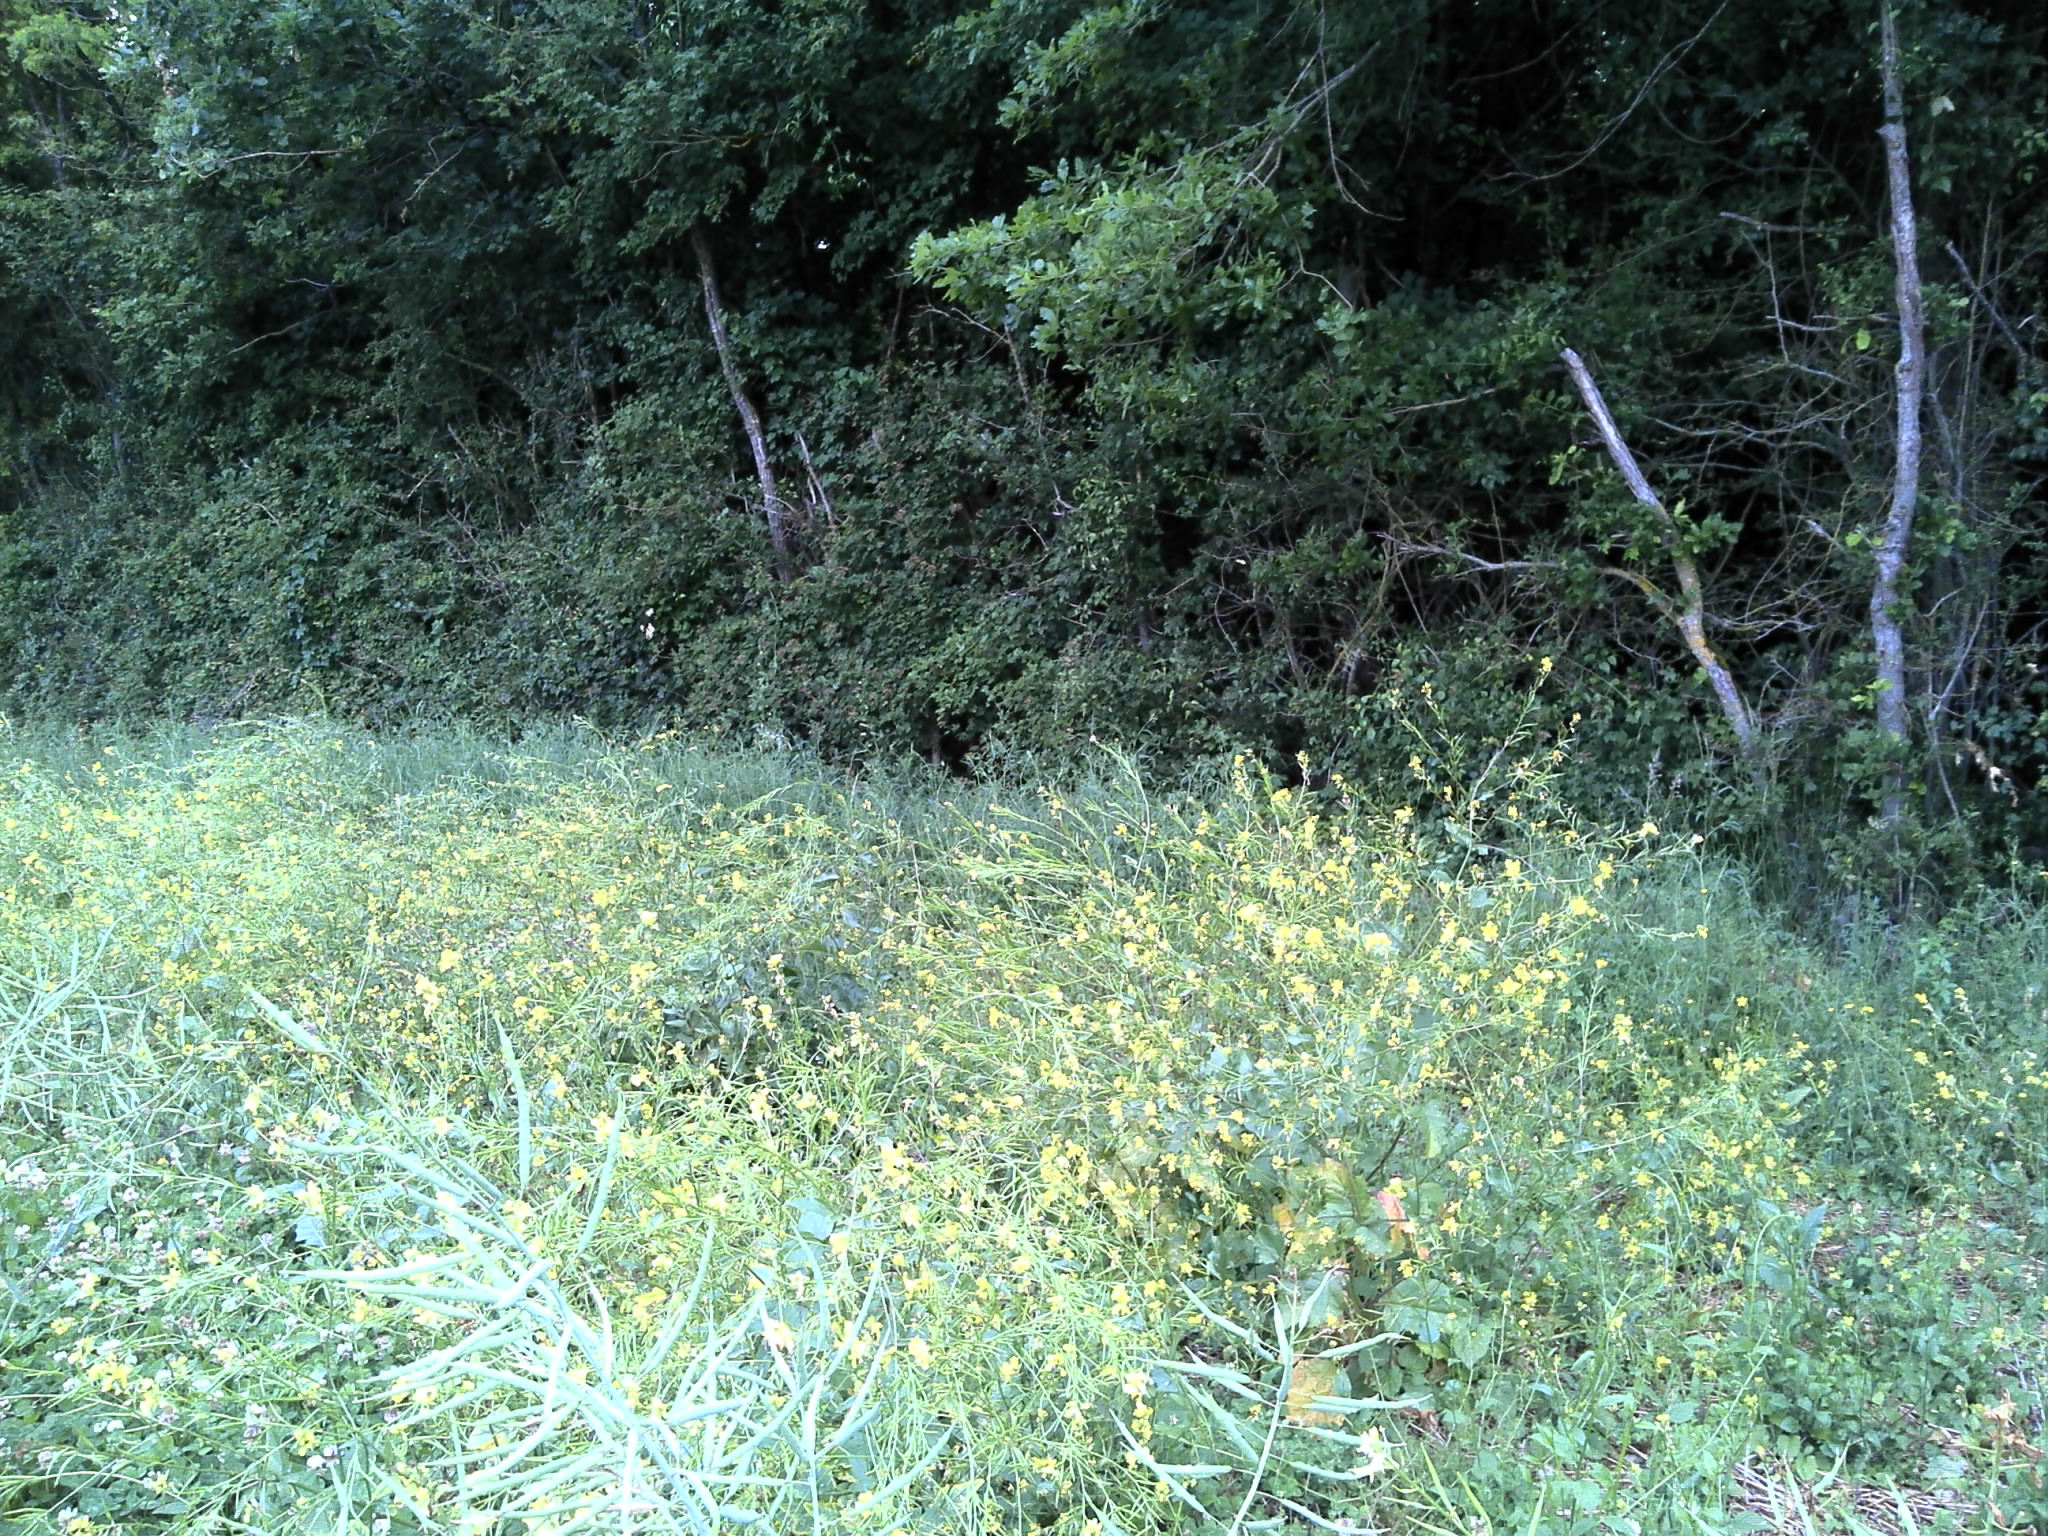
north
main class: Cropland
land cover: Rape and turnip rape
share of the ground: > 75 %
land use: Agriculture (excluding fallow land and kitchen gardens)
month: June
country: FR
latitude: 46.6290
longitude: 1.5126
